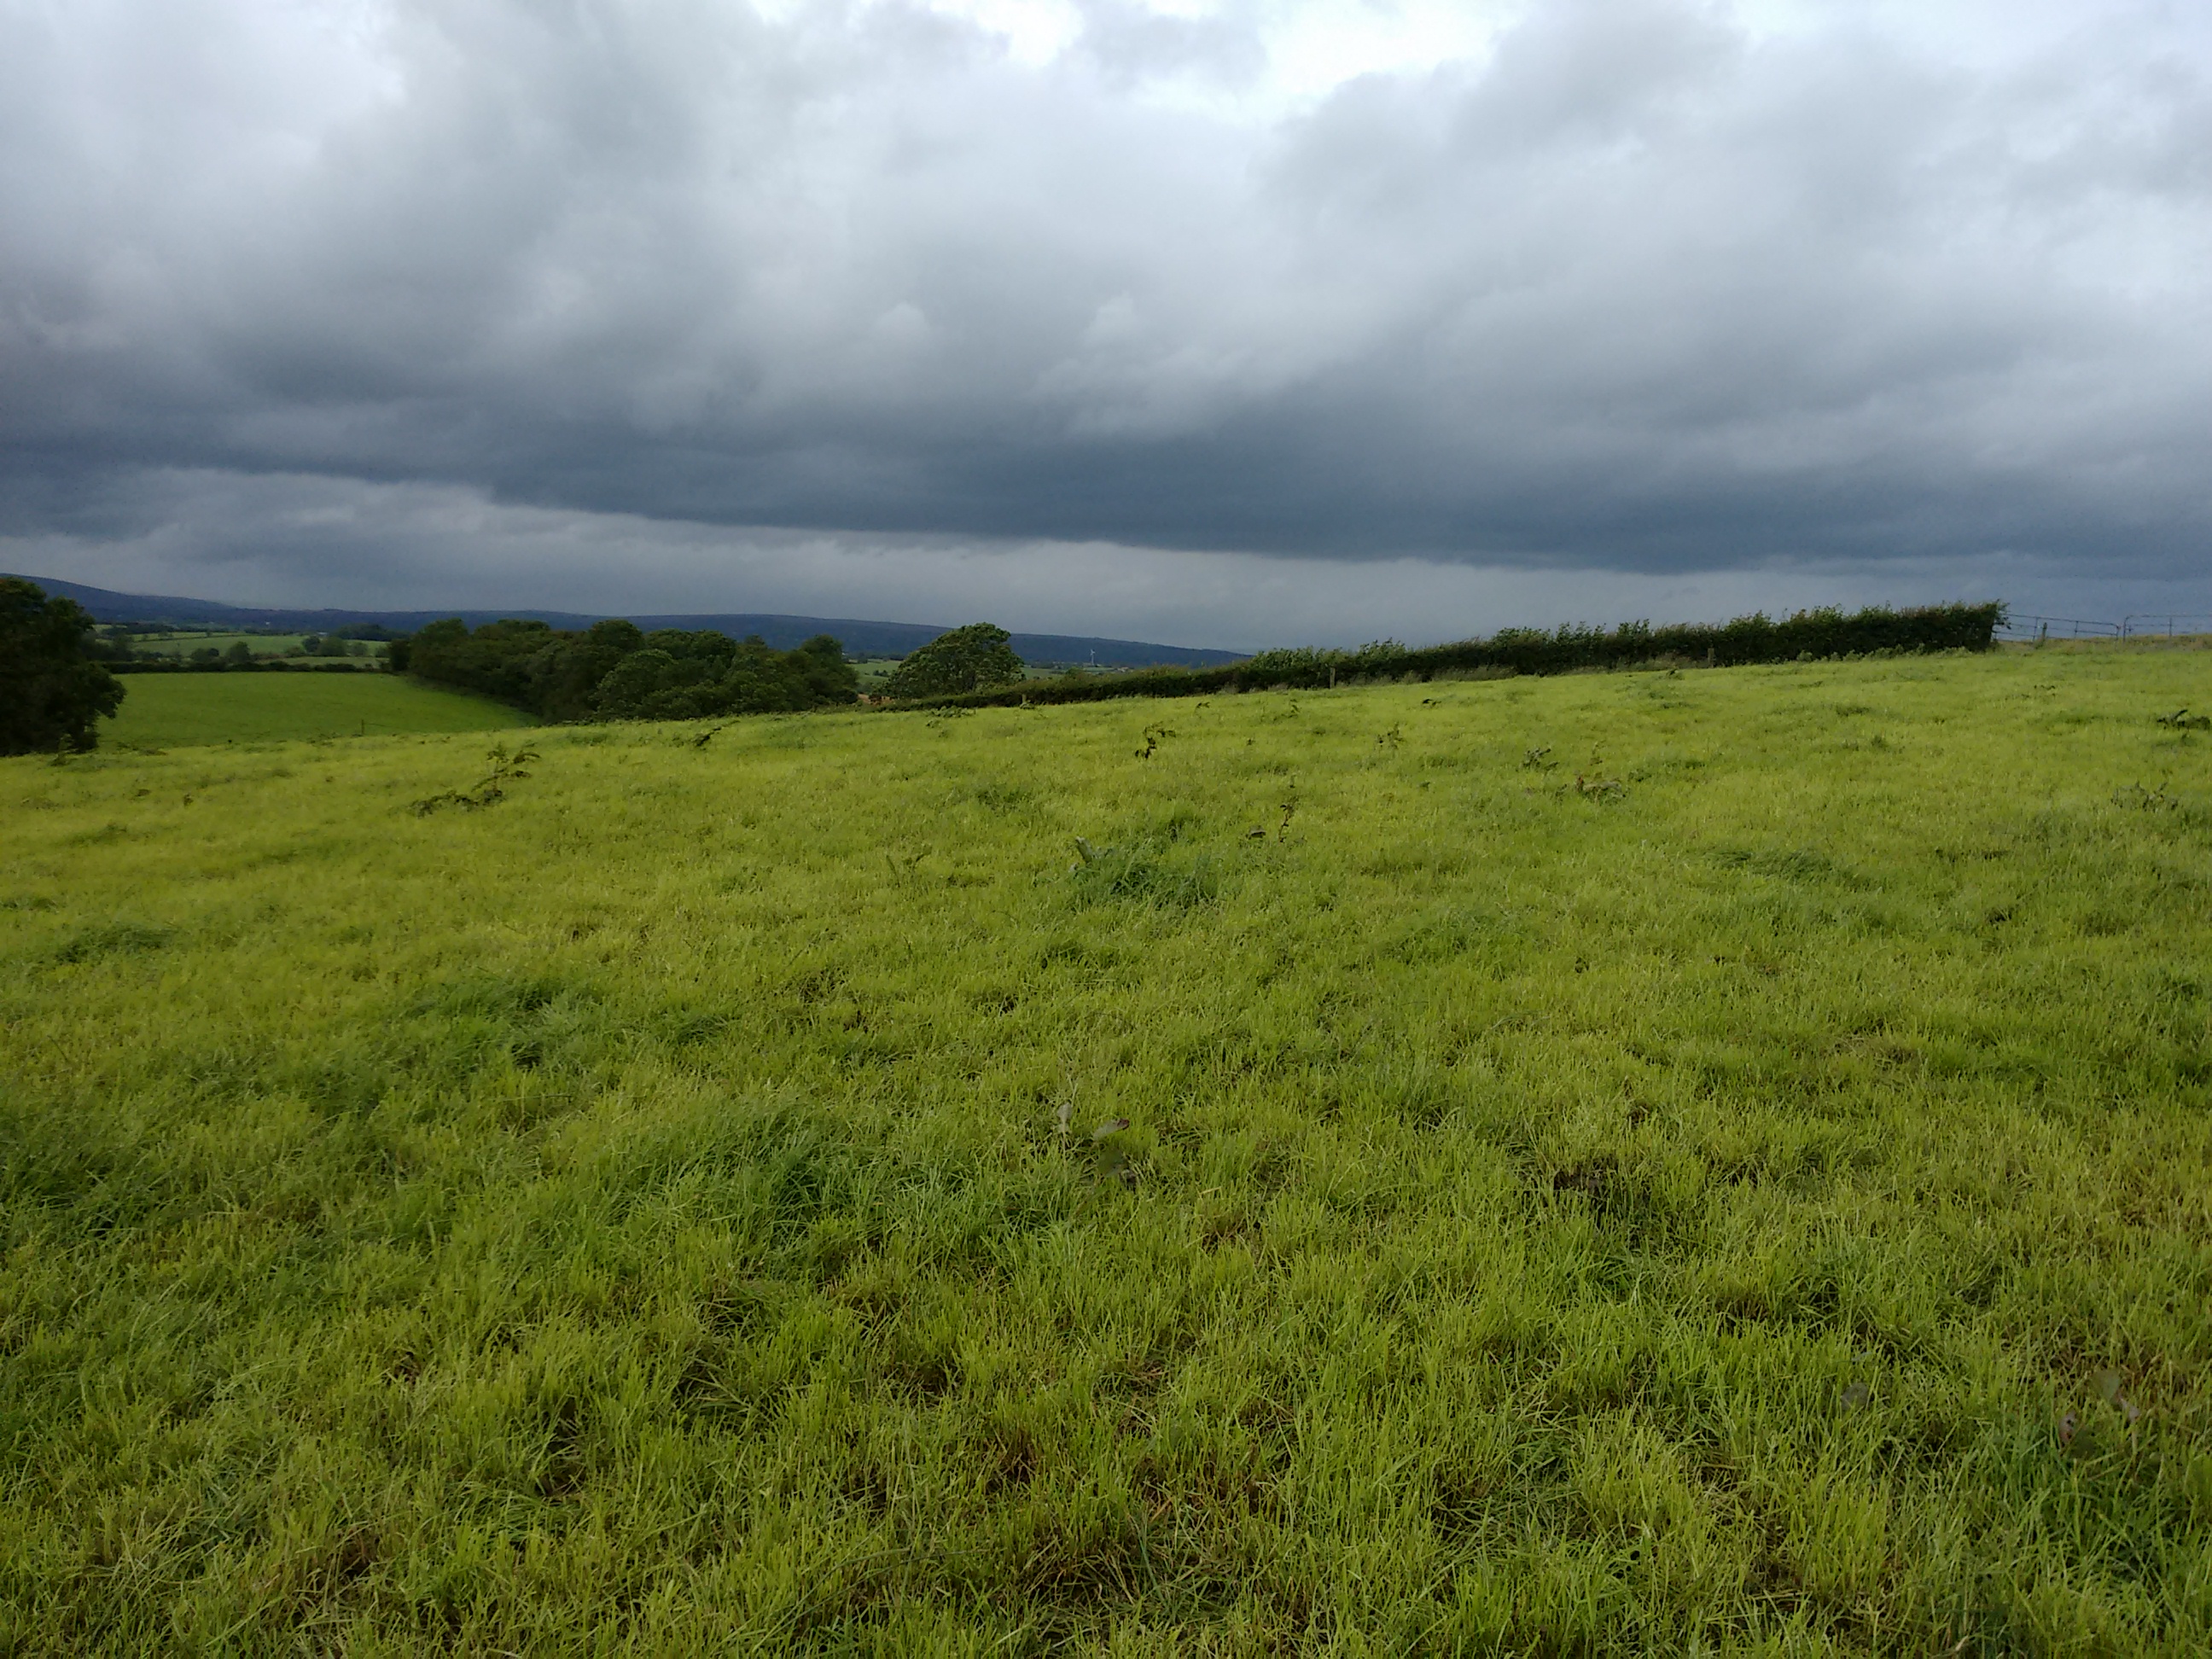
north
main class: Grassland
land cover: Grassland without tree/shrub cover
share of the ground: > 75 %
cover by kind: herbaceous plants 100 %
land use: Agriculture (excluding fallow land and kitchen gardens)
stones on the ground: < 10 %
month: July
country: GB
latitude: 54.4916
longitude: -7.3649
